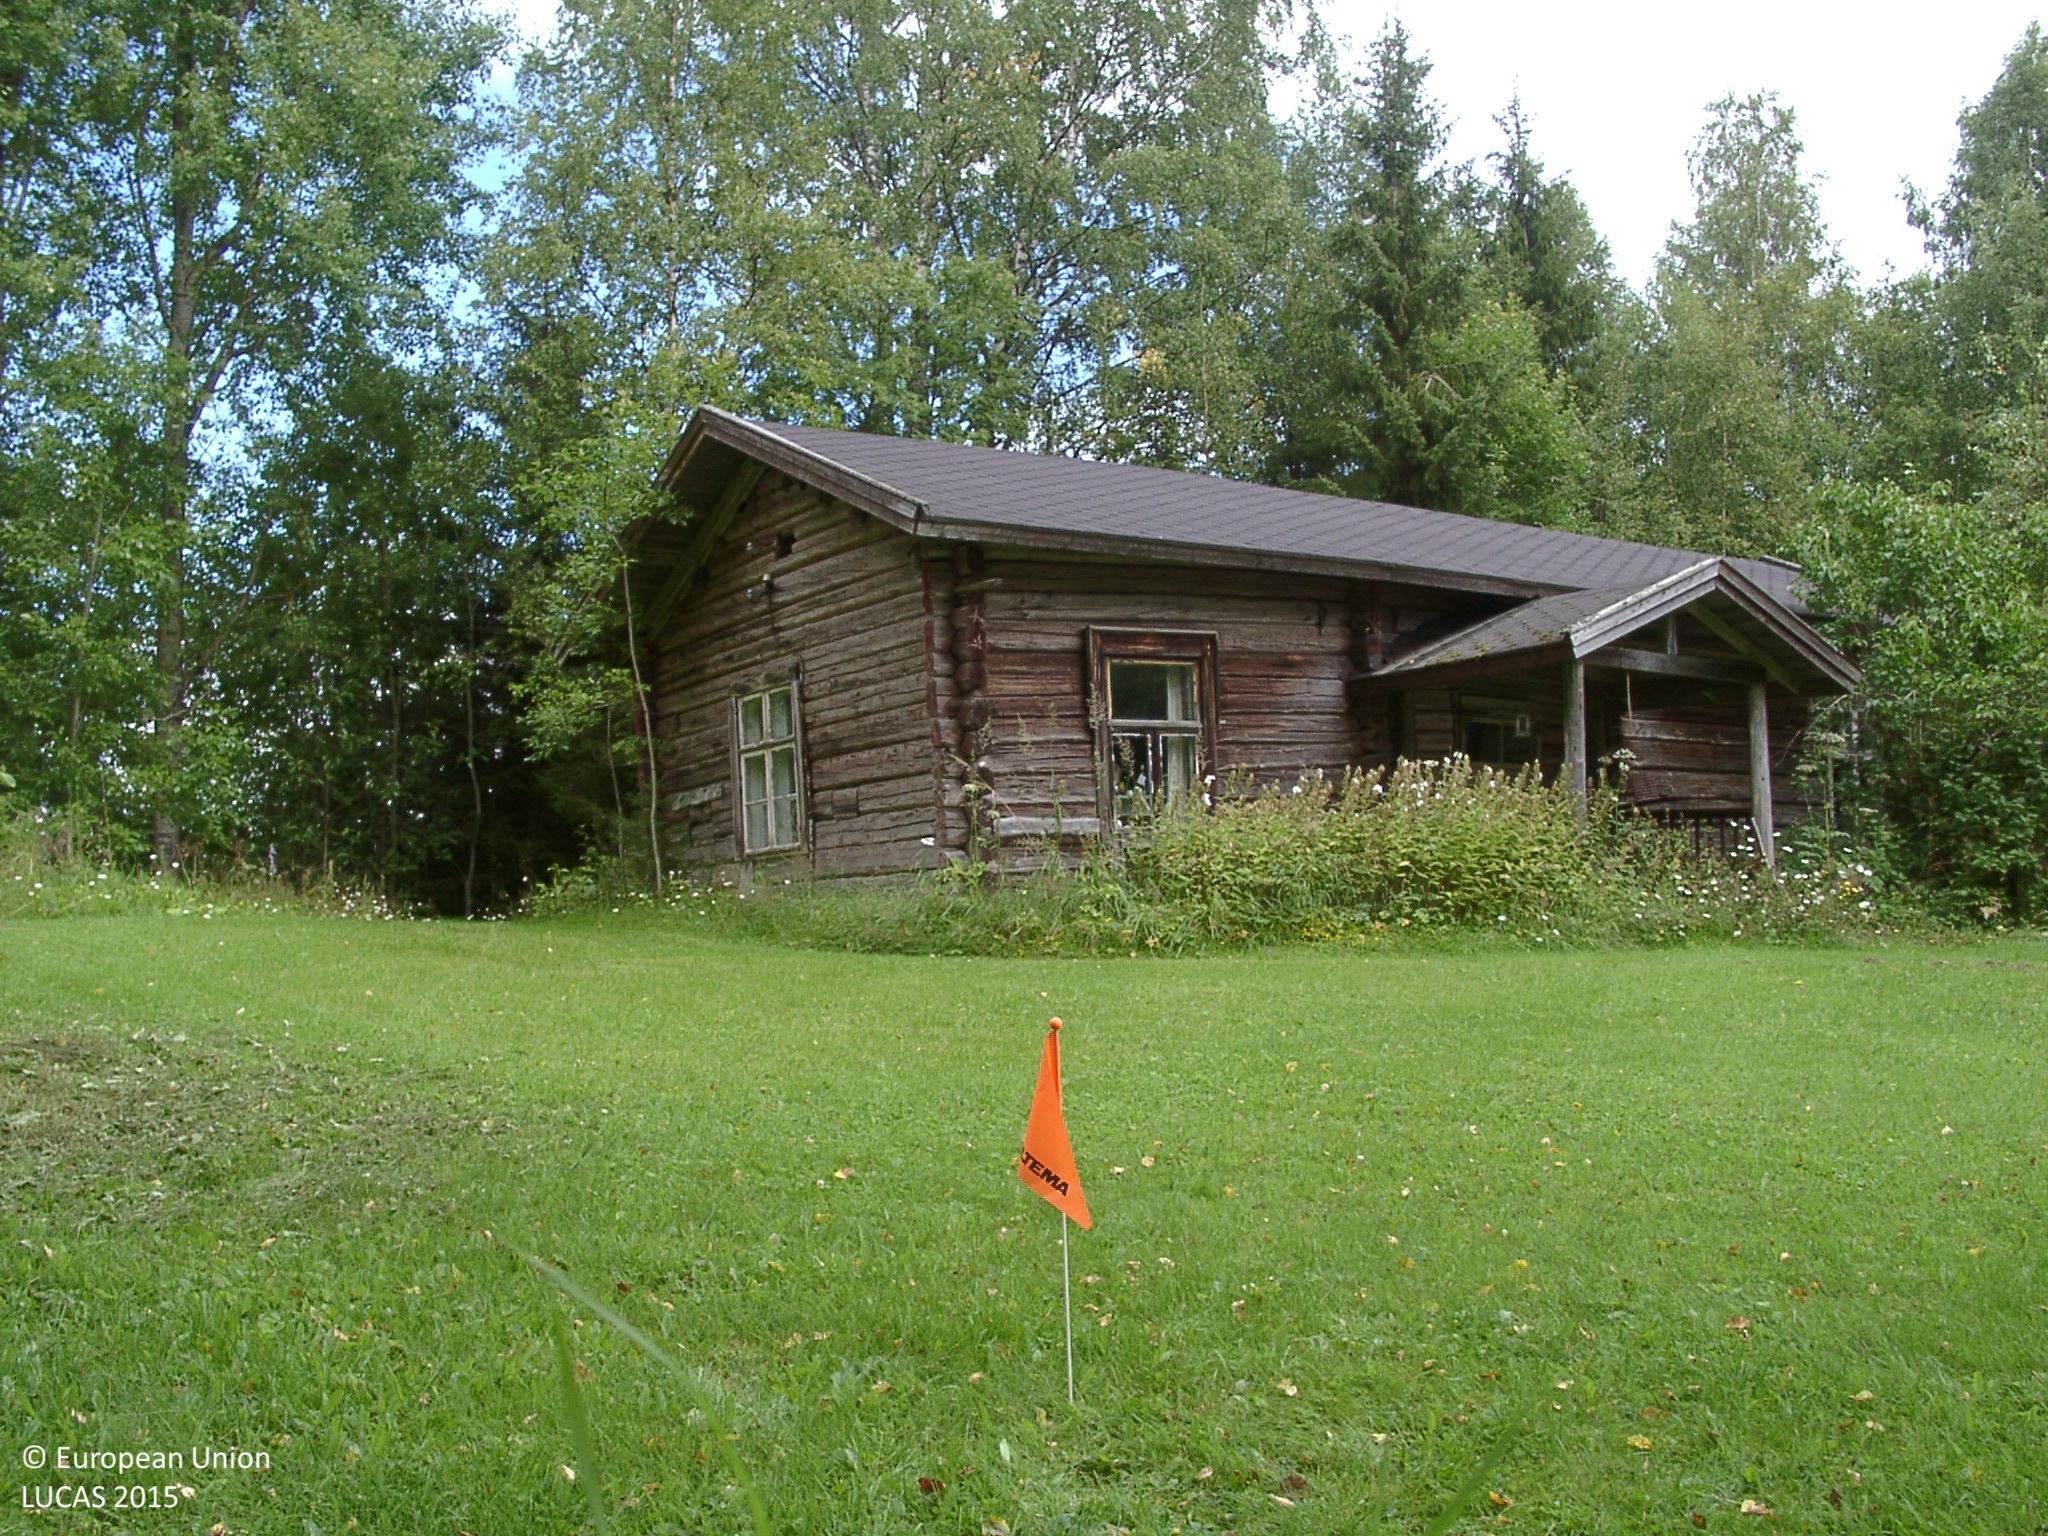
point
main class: Grassland
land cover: Grassland without tree/shrub cover
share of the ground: > 75 %
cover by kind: herbaceous plants 75 %, lichens and mosses 25 %
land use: Residential
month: August
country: FI
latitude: 62.4286
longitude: 25.5089
